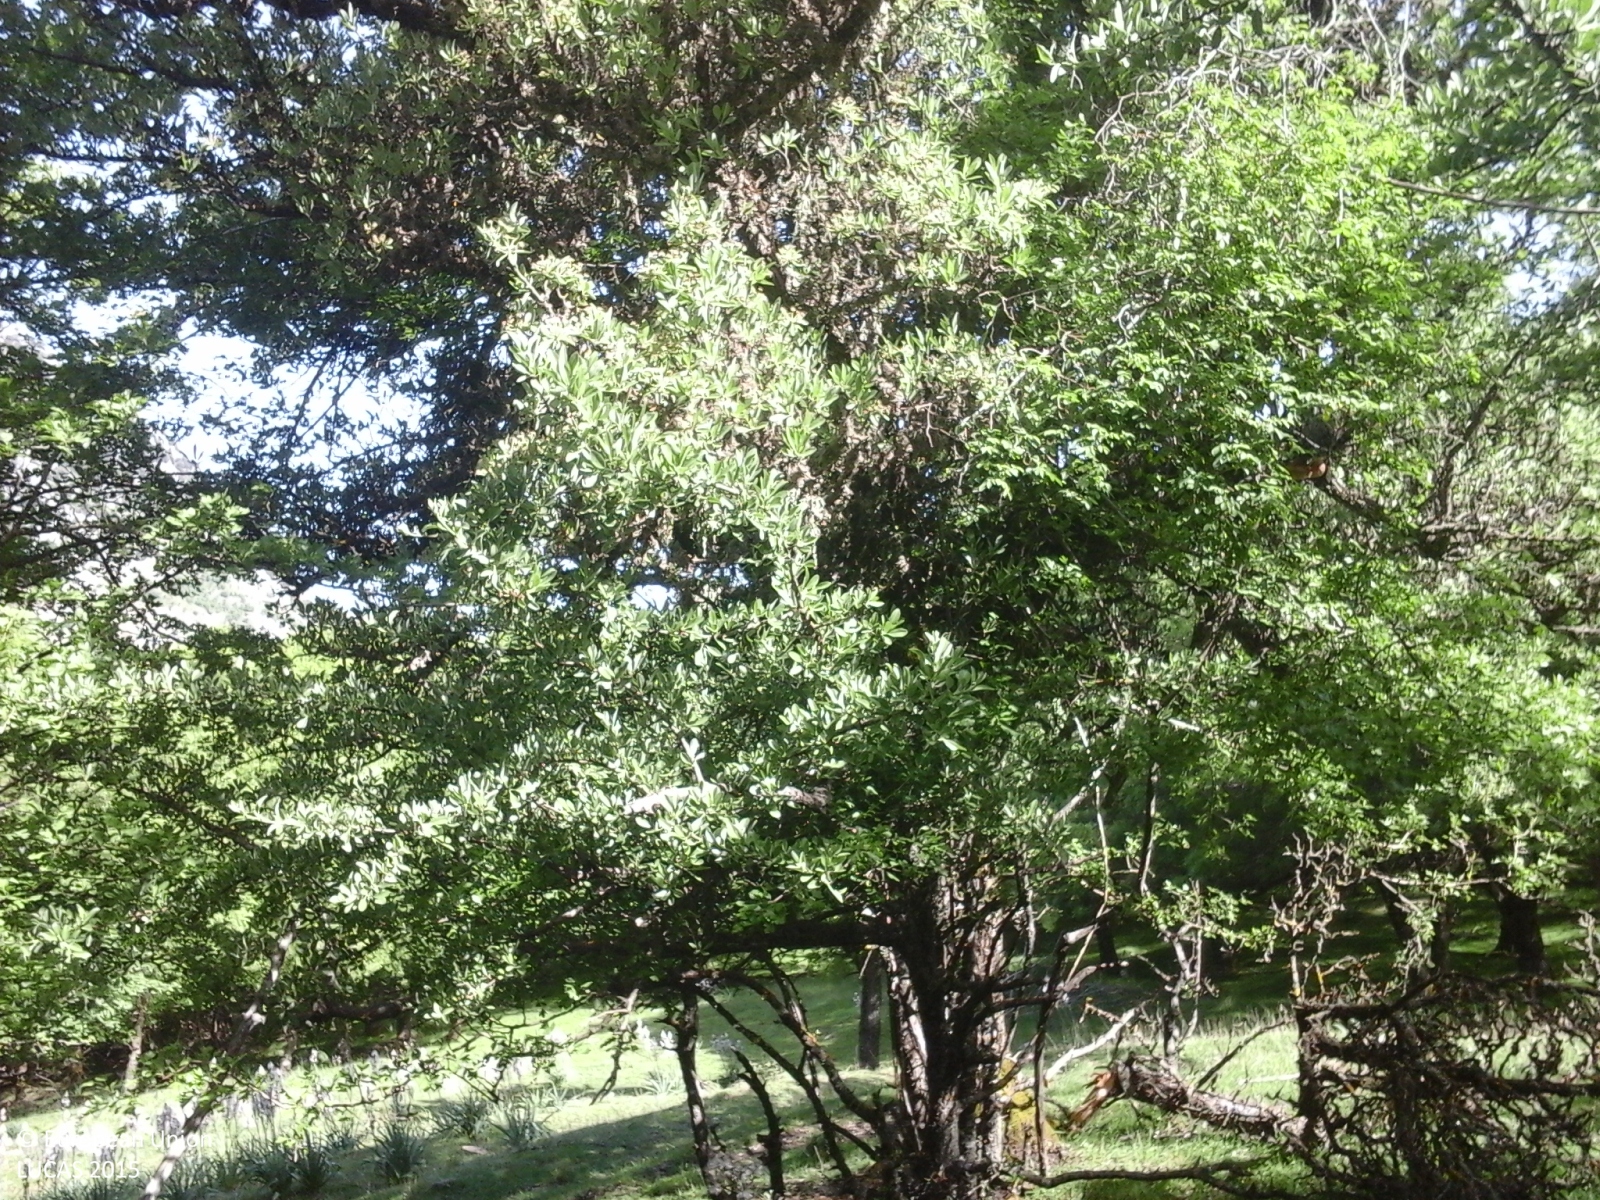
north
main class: Woodland
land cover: Broadleaved woodland
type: thermophilous deciduous forest
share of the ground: > 75 %
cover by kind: broadleaved forest trees 80 %, herbaceous plants 10 %, shrubs 5 %, consolidated bare surface 5 %
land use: Forestry
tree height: > 5 m
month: May
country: IT
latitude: 37.8811
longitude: 14.0078
